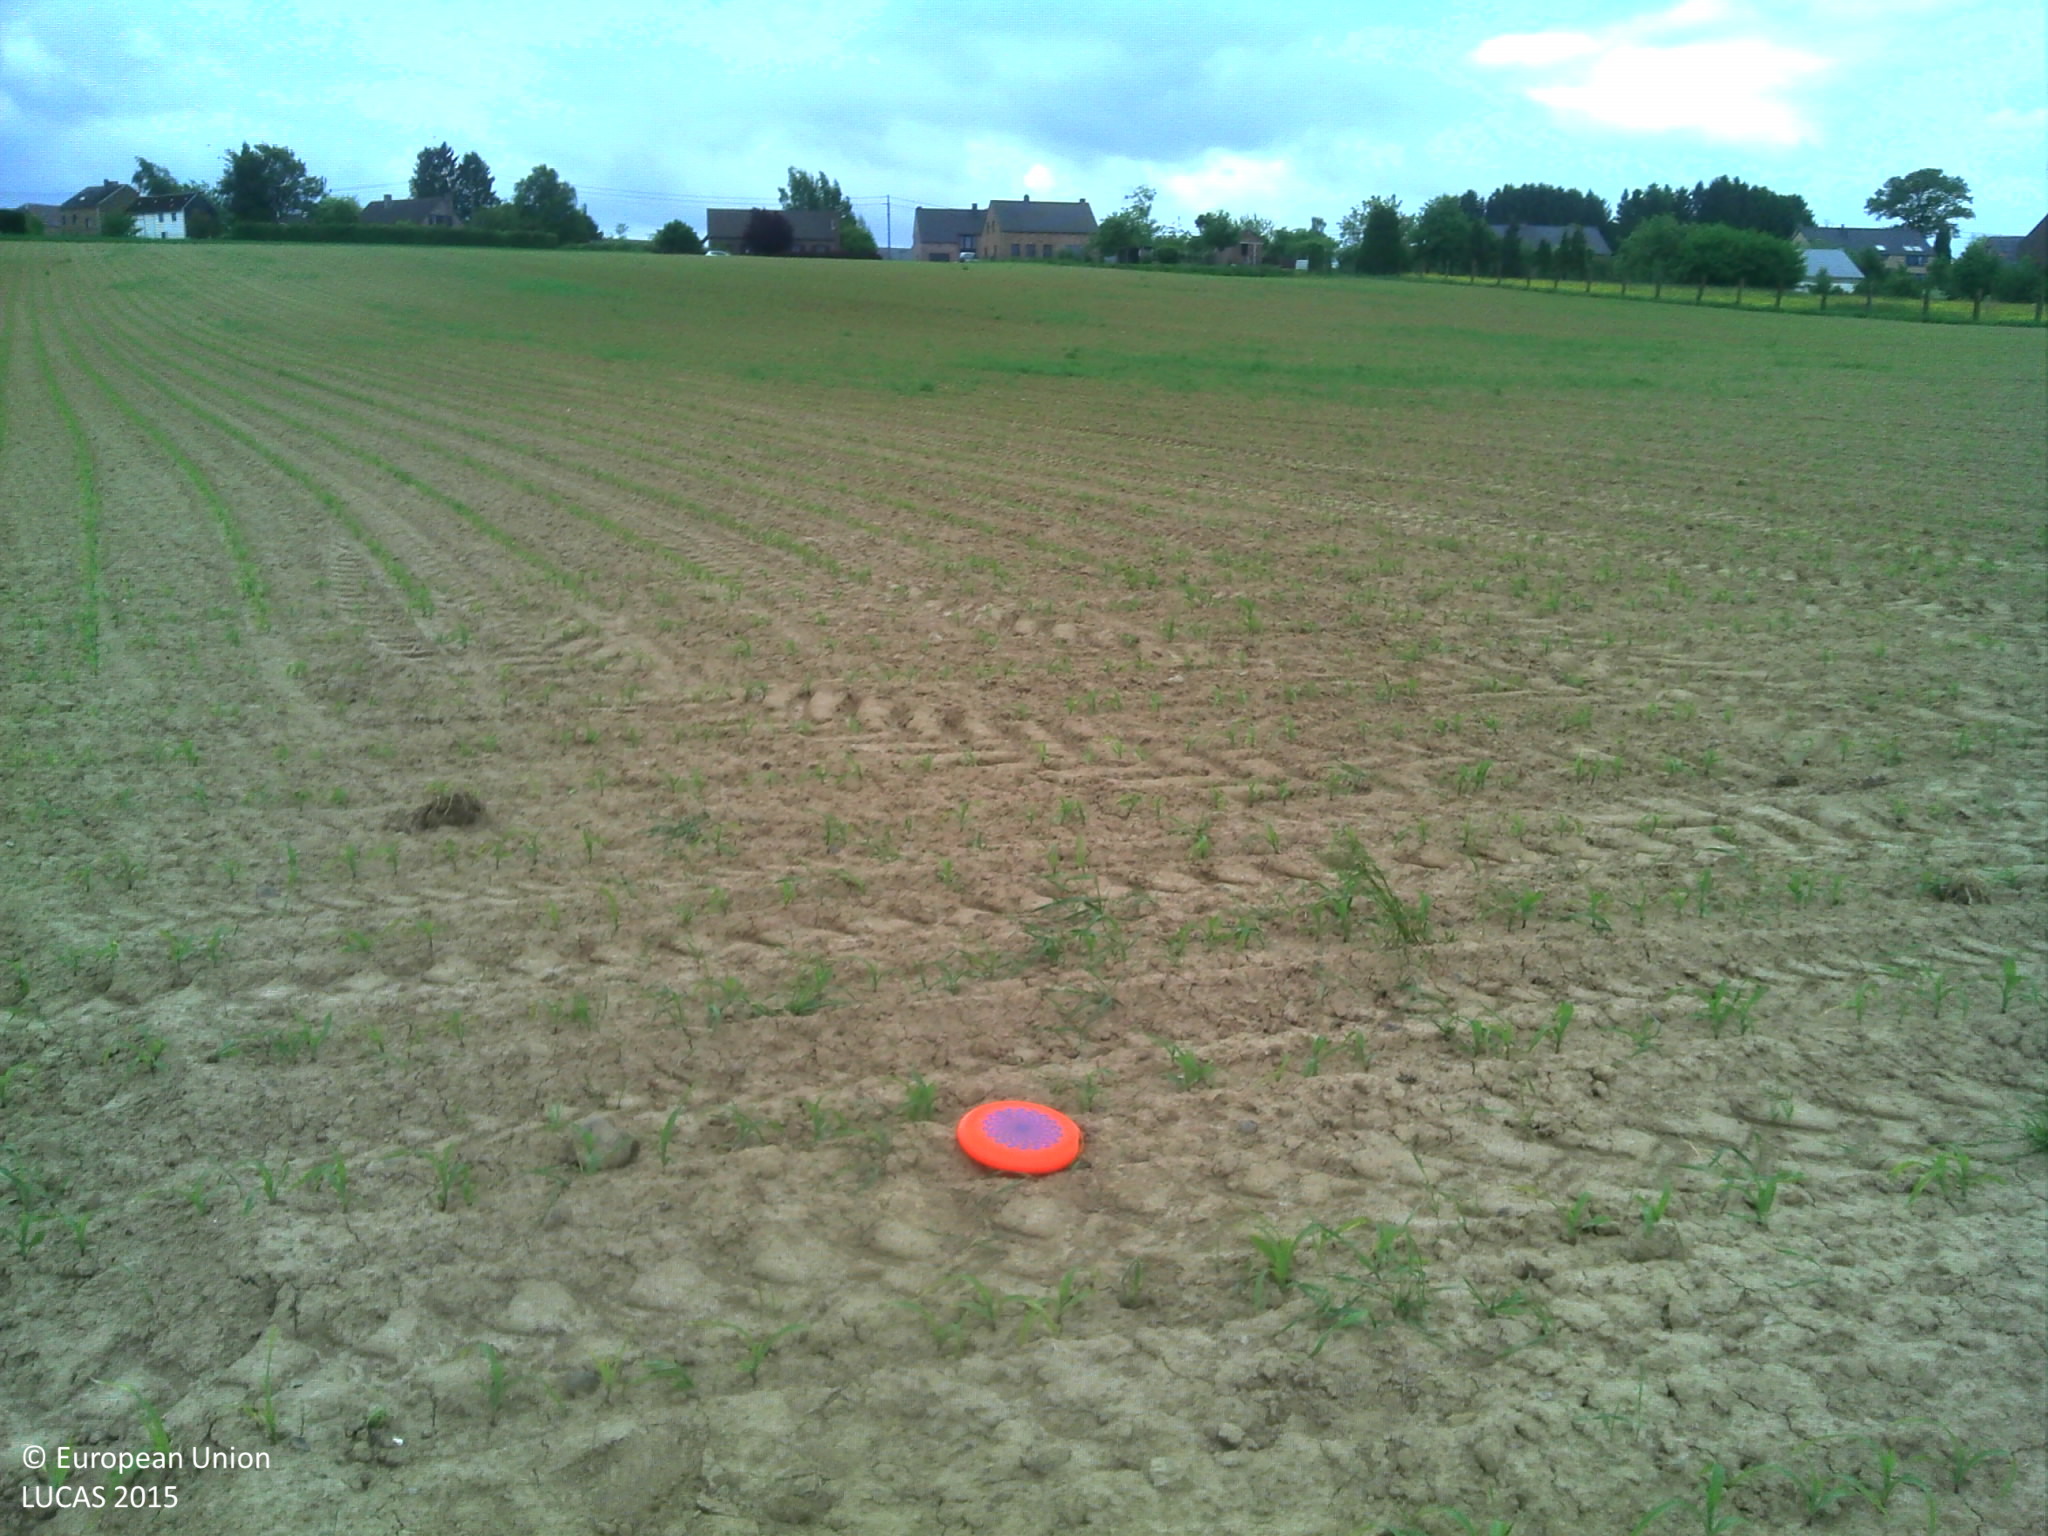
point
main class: Cropland
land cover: Maize
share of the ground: < 10 %
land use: Agriculture (excluding fallow land and kitchen gardens)
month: May
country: BE
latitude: 50.3548
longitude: 5.2330
